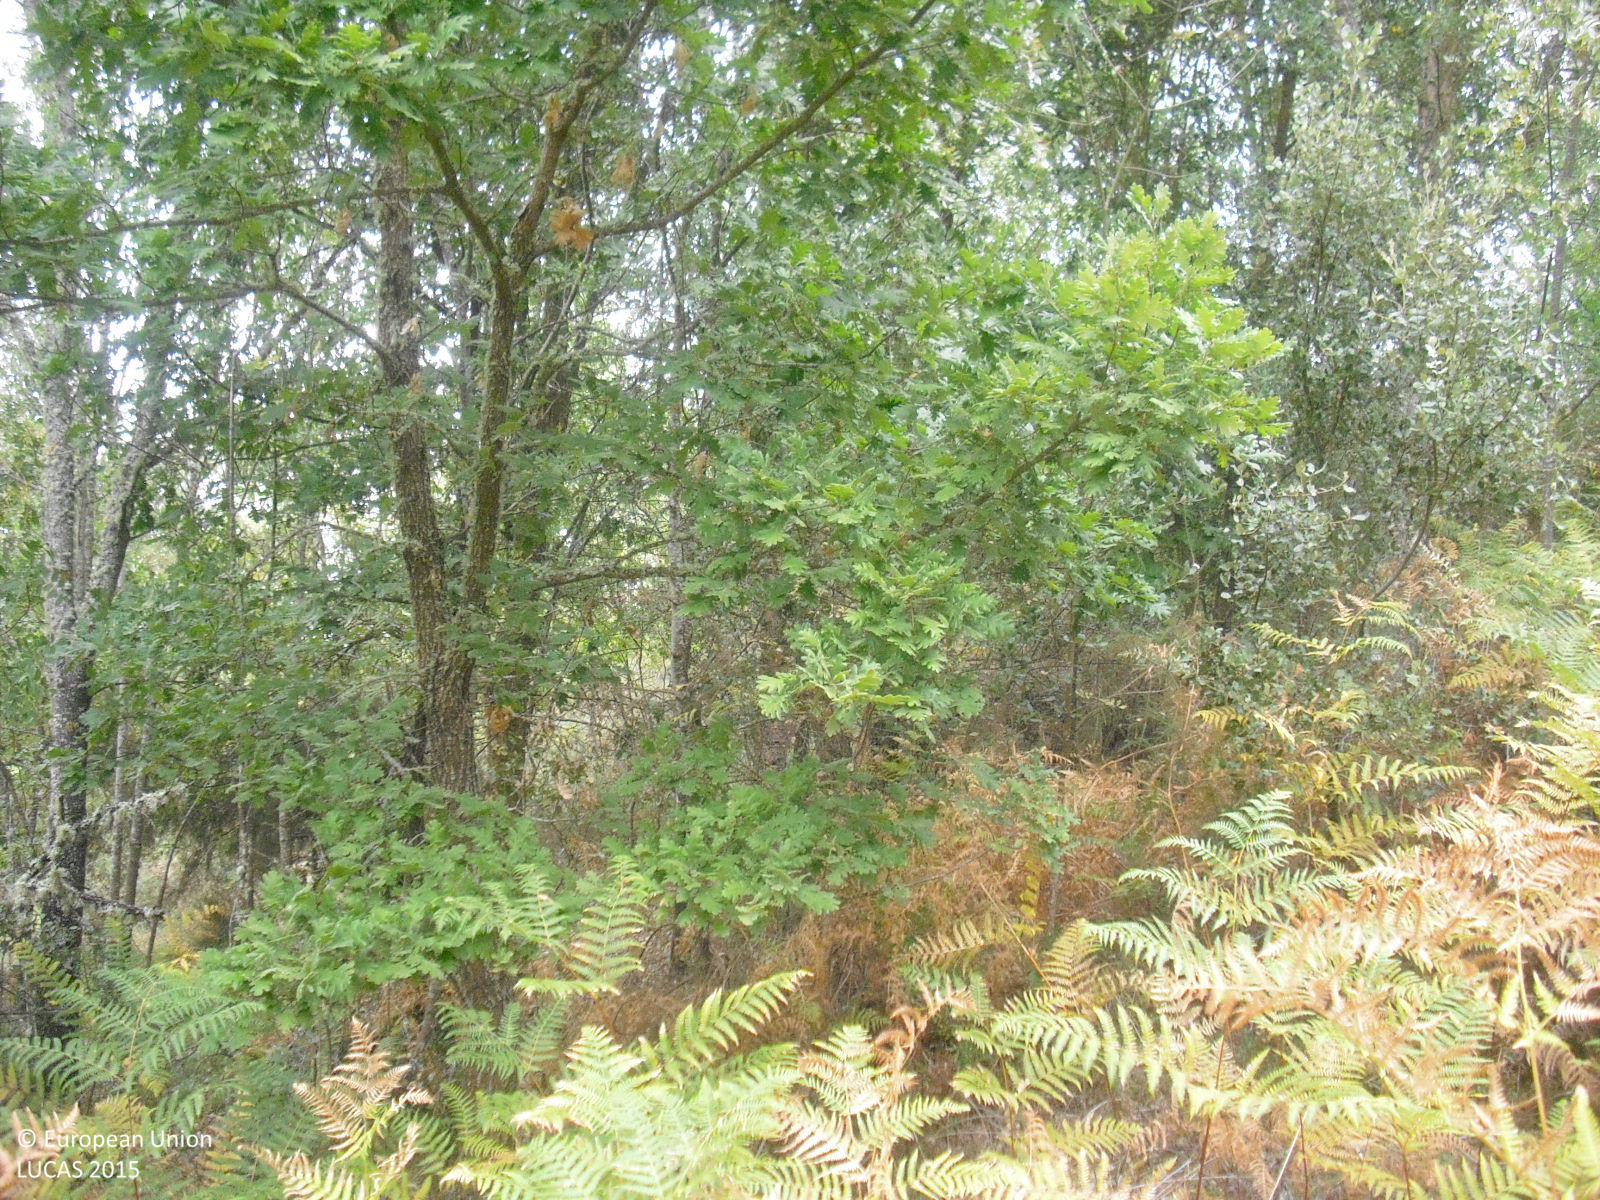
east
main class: Woodland
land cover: Broadleaved woodland
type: thermophilous deciduous forest
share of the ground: 50 - 75 %
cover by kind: broadleaved forest trees 60 %, shrubs 20 %, herbaceous plants 20 %
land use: Semi-natural and natural areas not in use
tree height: > 5 m
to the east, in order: Broadleaved woodland; Grassland with sparse tree/shrub cover; Shrubland with sparse tree cover; Grass margins; Paved roads, cycling and walking lanes; Grass margins; Ditches and canals; Shruby margins; Pine dominated mixed woodland; Grass margins; Paved roads, cycling and walking lanes; Grass margins; Ditches and canals; Shrubland without tree cover; Nuts trees; Shrubland with sparse tree cover; Shrubland without tree cover
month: July
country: ES
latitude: 42.3992
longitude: -7.2271
